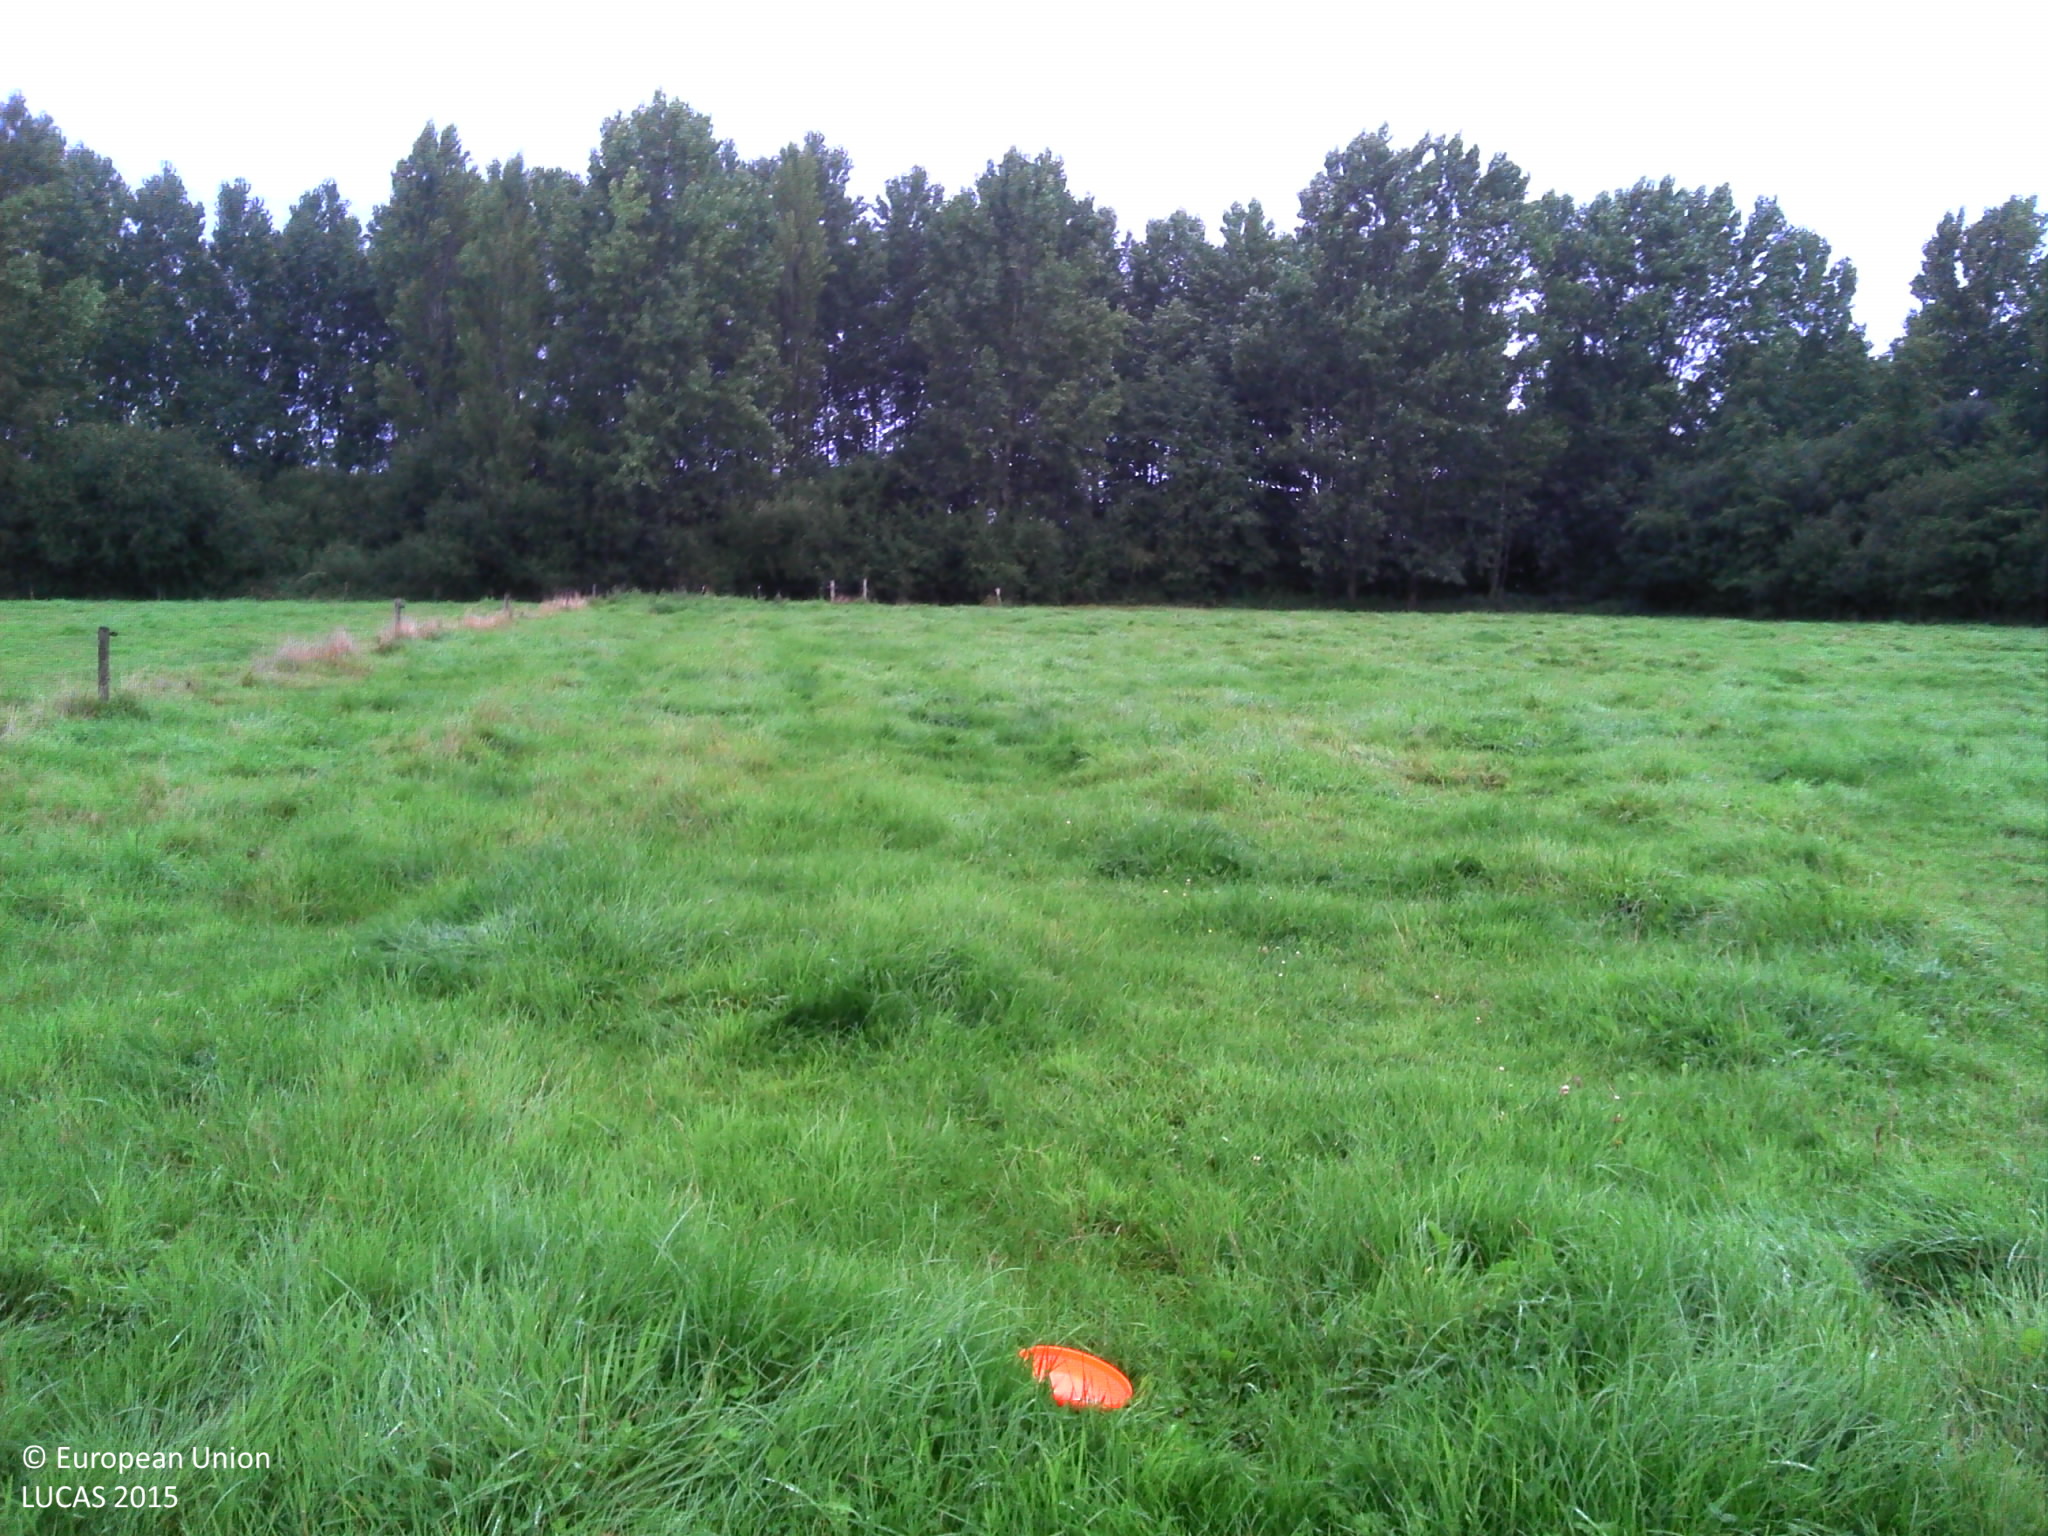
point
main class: Grassland
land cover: Grassland without tree/shrub cover
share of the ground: > 75 %
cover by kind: herbaceous plants 100 %
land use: Agriculture (excluding fallow land and kitchen gardens)
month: September
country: BE
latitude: 51.4312
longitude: 4.7175
